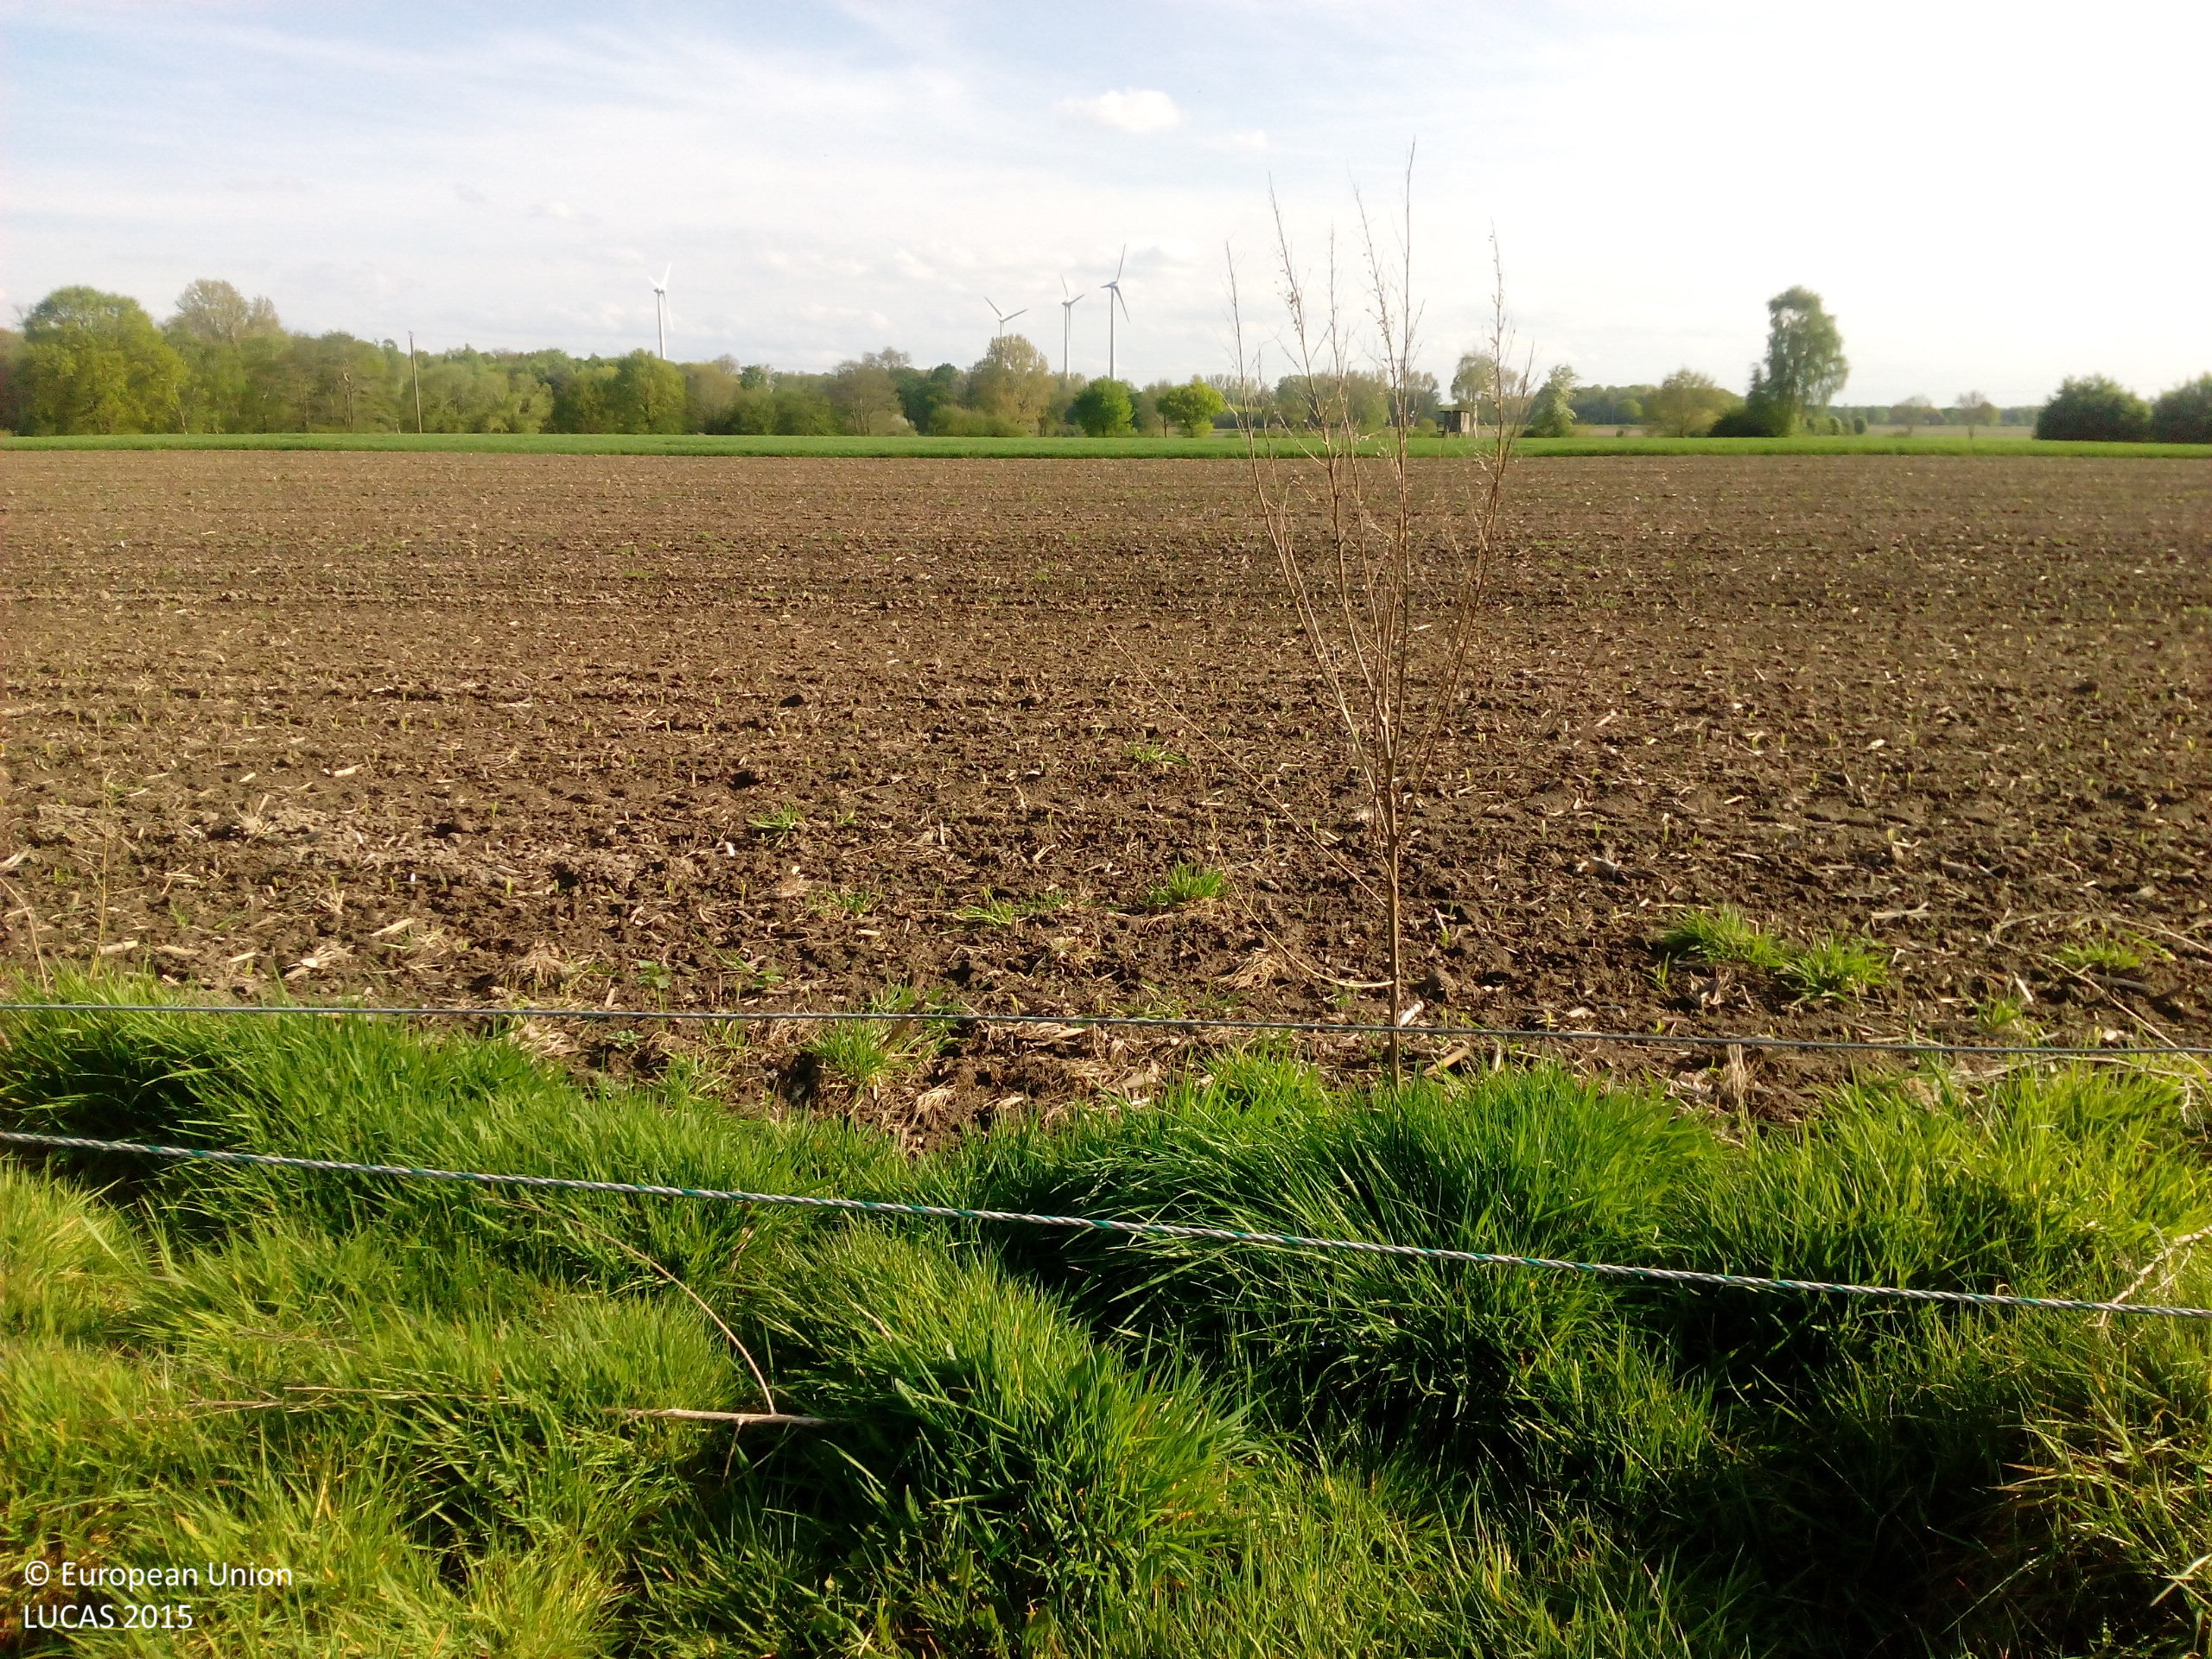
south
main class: Grassland
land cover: Grassland without tree/shrub cover
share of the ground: > 75 %
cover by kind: herbaceous plants 100 %
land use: Agriculture (excluding fallow land and kitchen gardens)
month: May
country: DE
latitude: 51.7390
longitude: 7.4660
